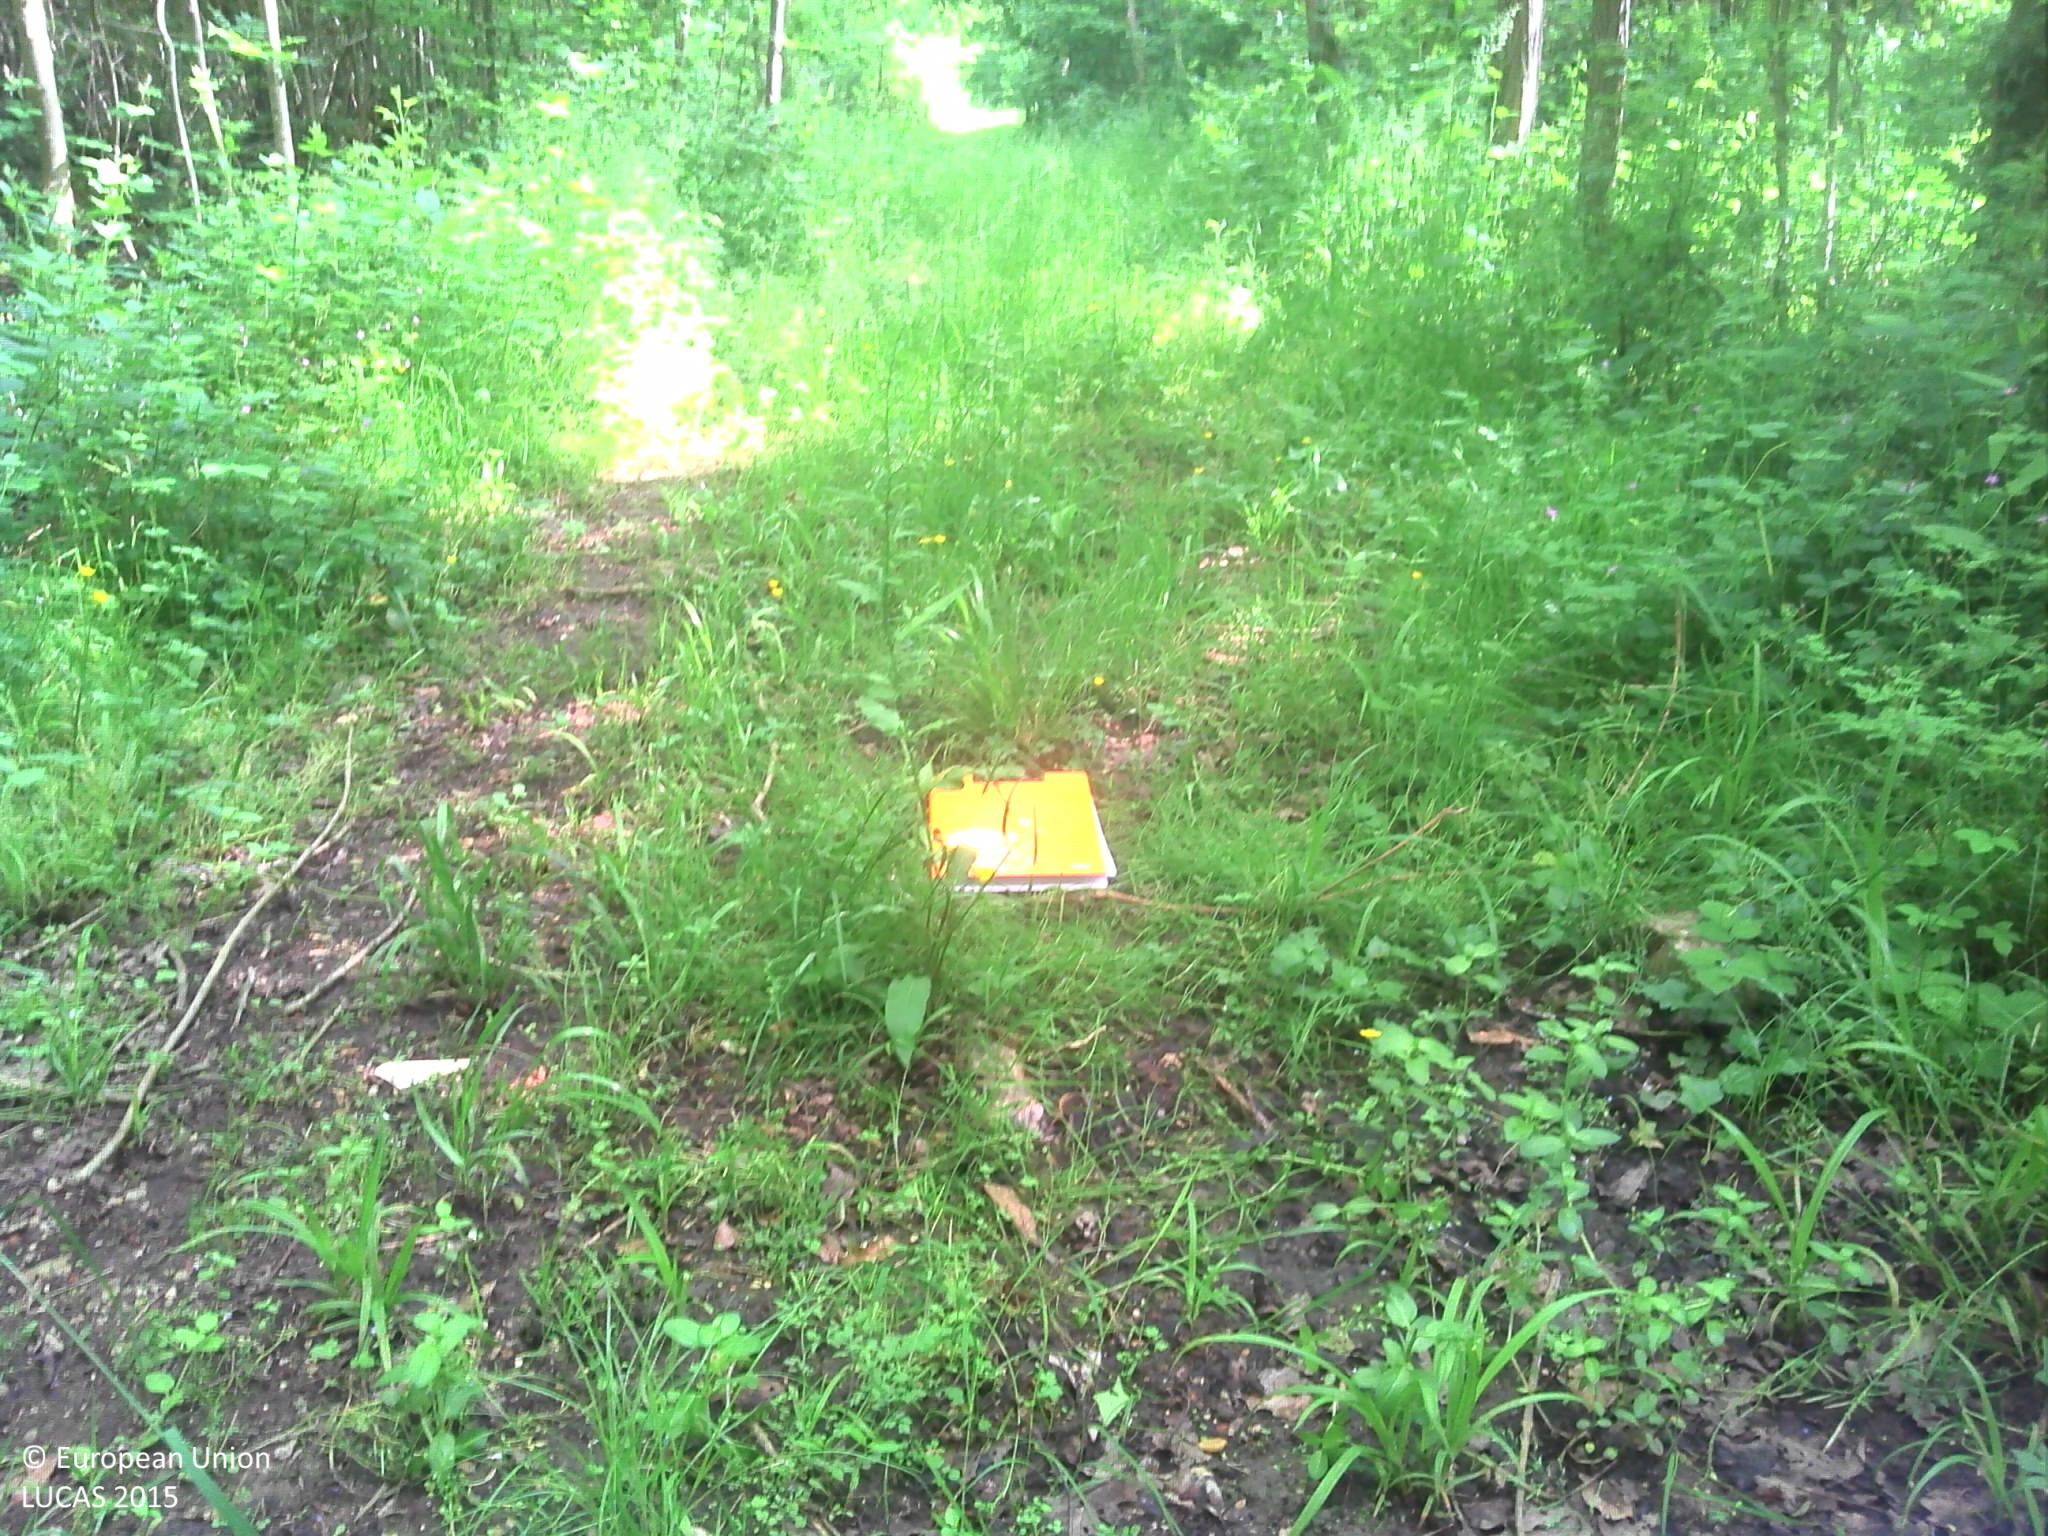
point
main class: Woodland
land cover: Broadleaved woodland
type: mesophytic deciduous forest
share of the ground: > 75 %
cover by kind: broadleaved forest trees 90 %, herbaceous plants 10 %
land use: Forestry
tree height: > 5 m
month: May
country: FR
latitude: 48.6827
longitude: 4.9045
